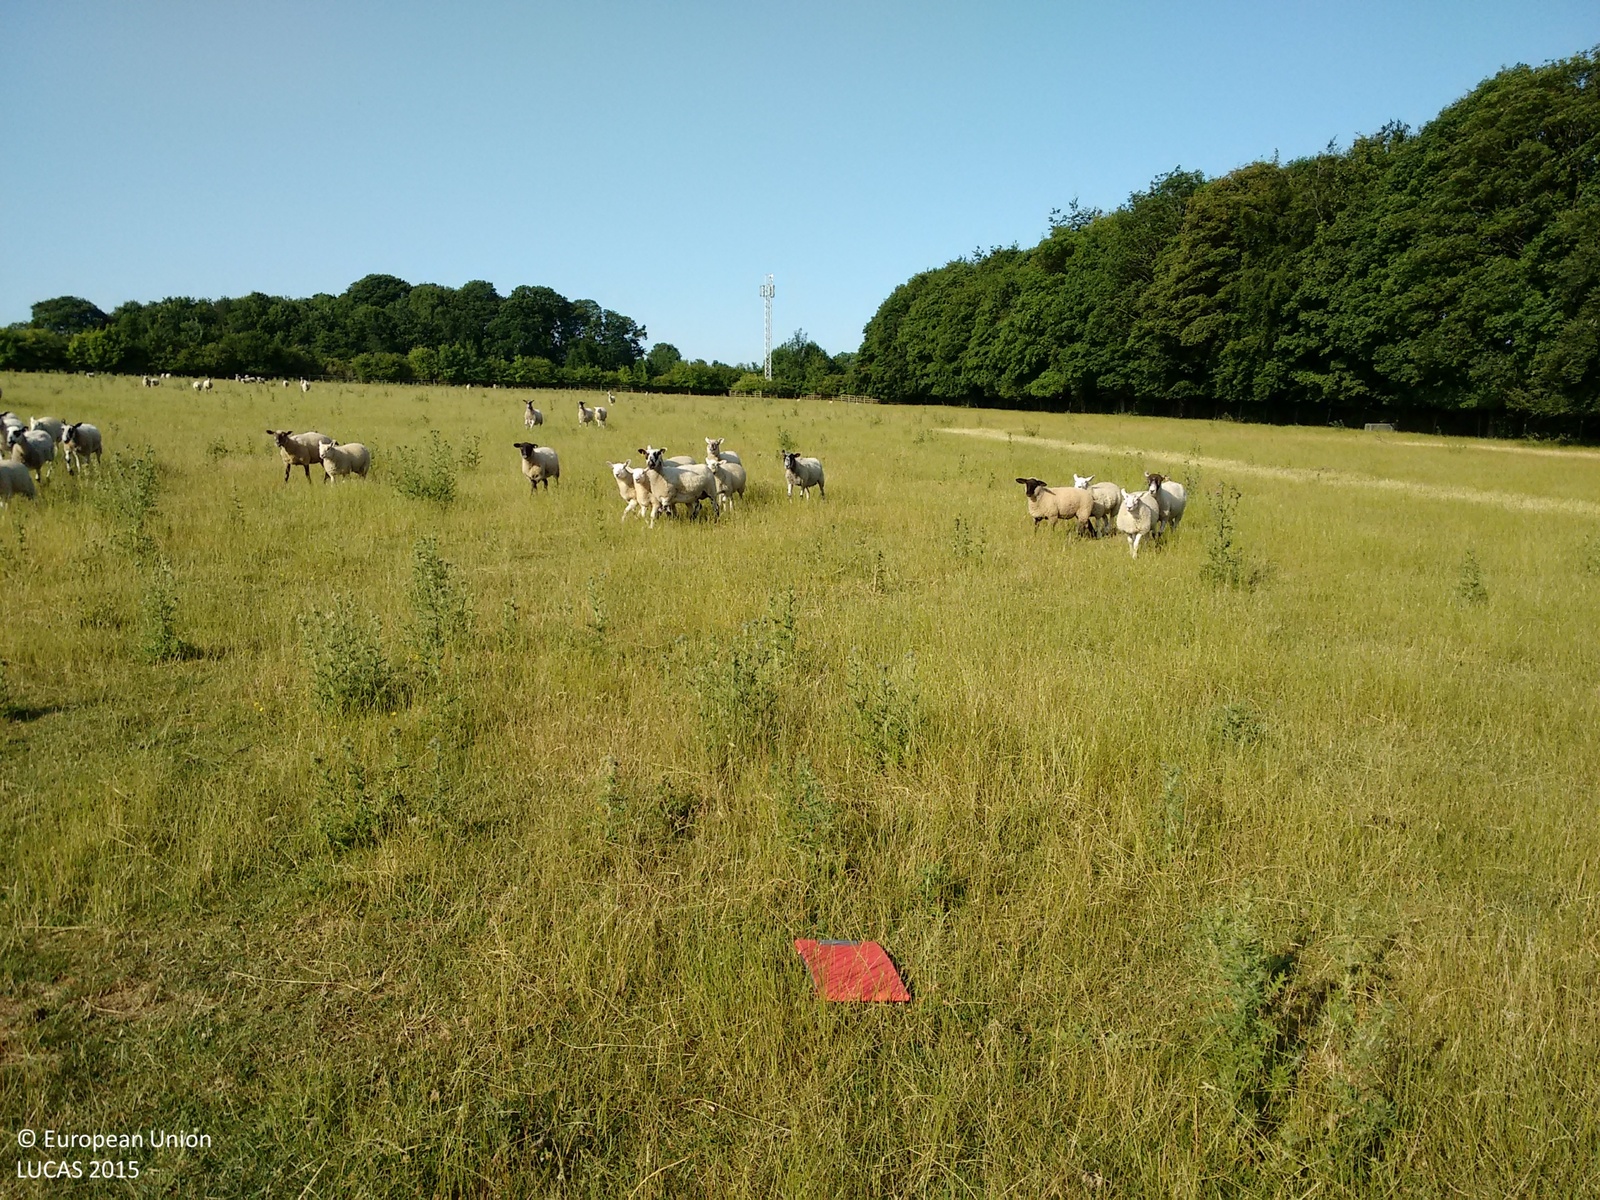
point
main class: Grassland
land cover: Grassland without tree/shrub cover
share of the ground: > 75 %
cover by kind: herbaceous plants 100 %
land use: Agriculture (excluding fallow land and kitchen gardens)
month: July
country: GB
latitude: 51.9688
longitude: -1.2409
